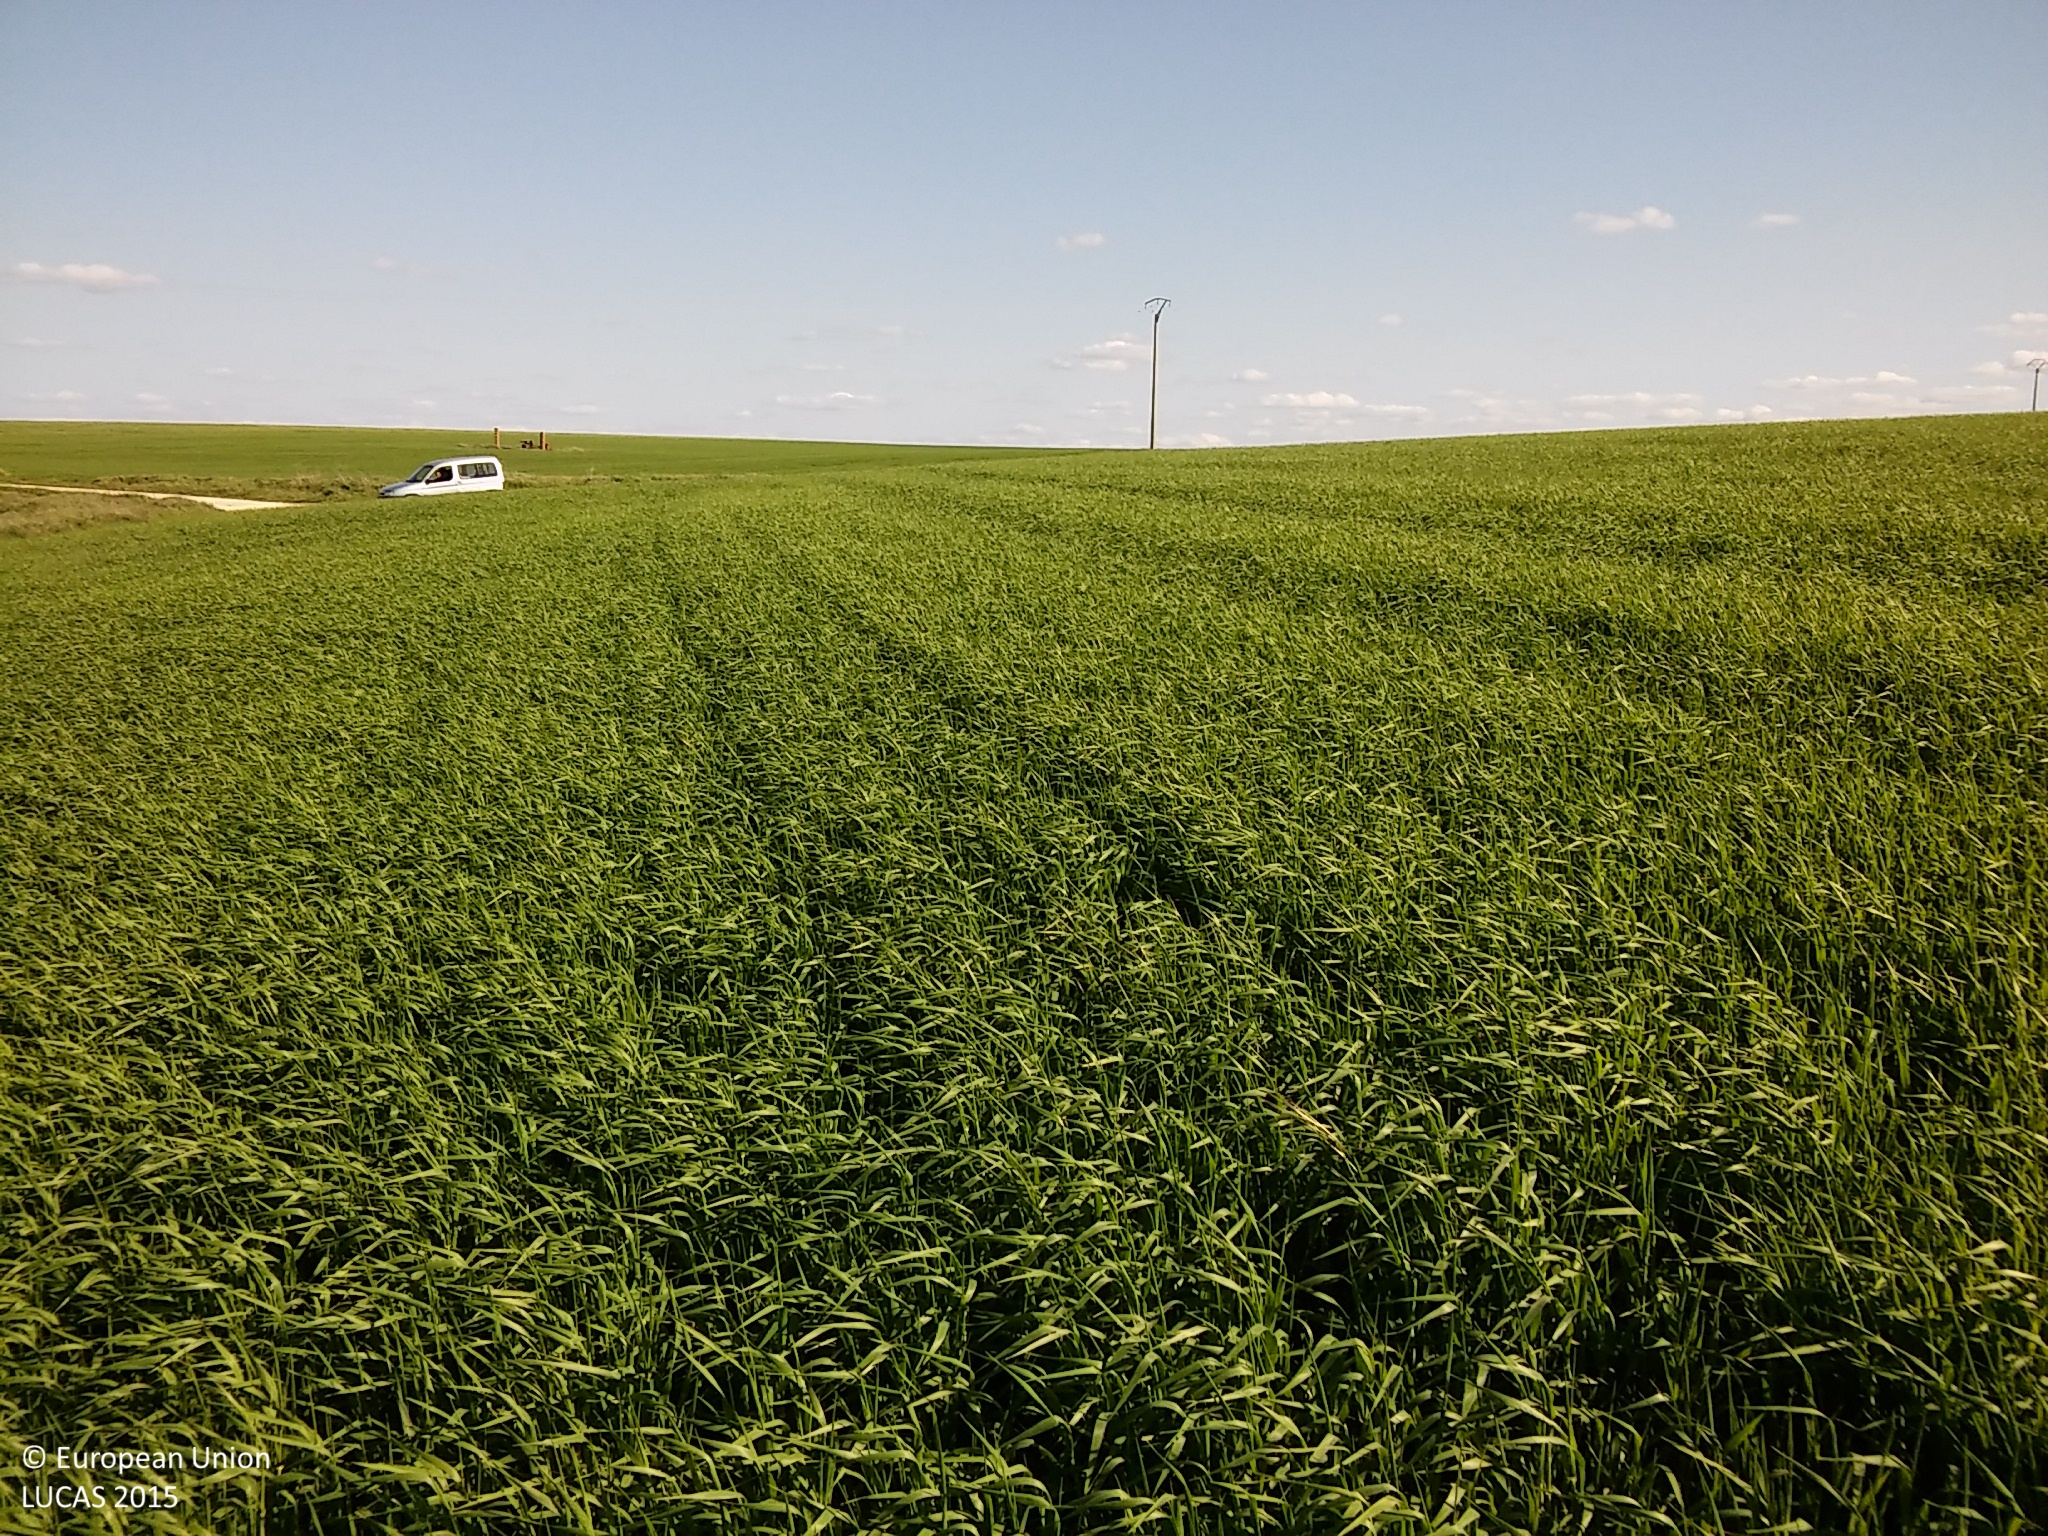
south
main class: Cropland
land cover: Barley
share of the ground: > 75 %
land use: Agriculture (excluding fallow land and kitchen gardens)
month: May
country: ES
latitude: 41.4641
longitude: -4.0763
